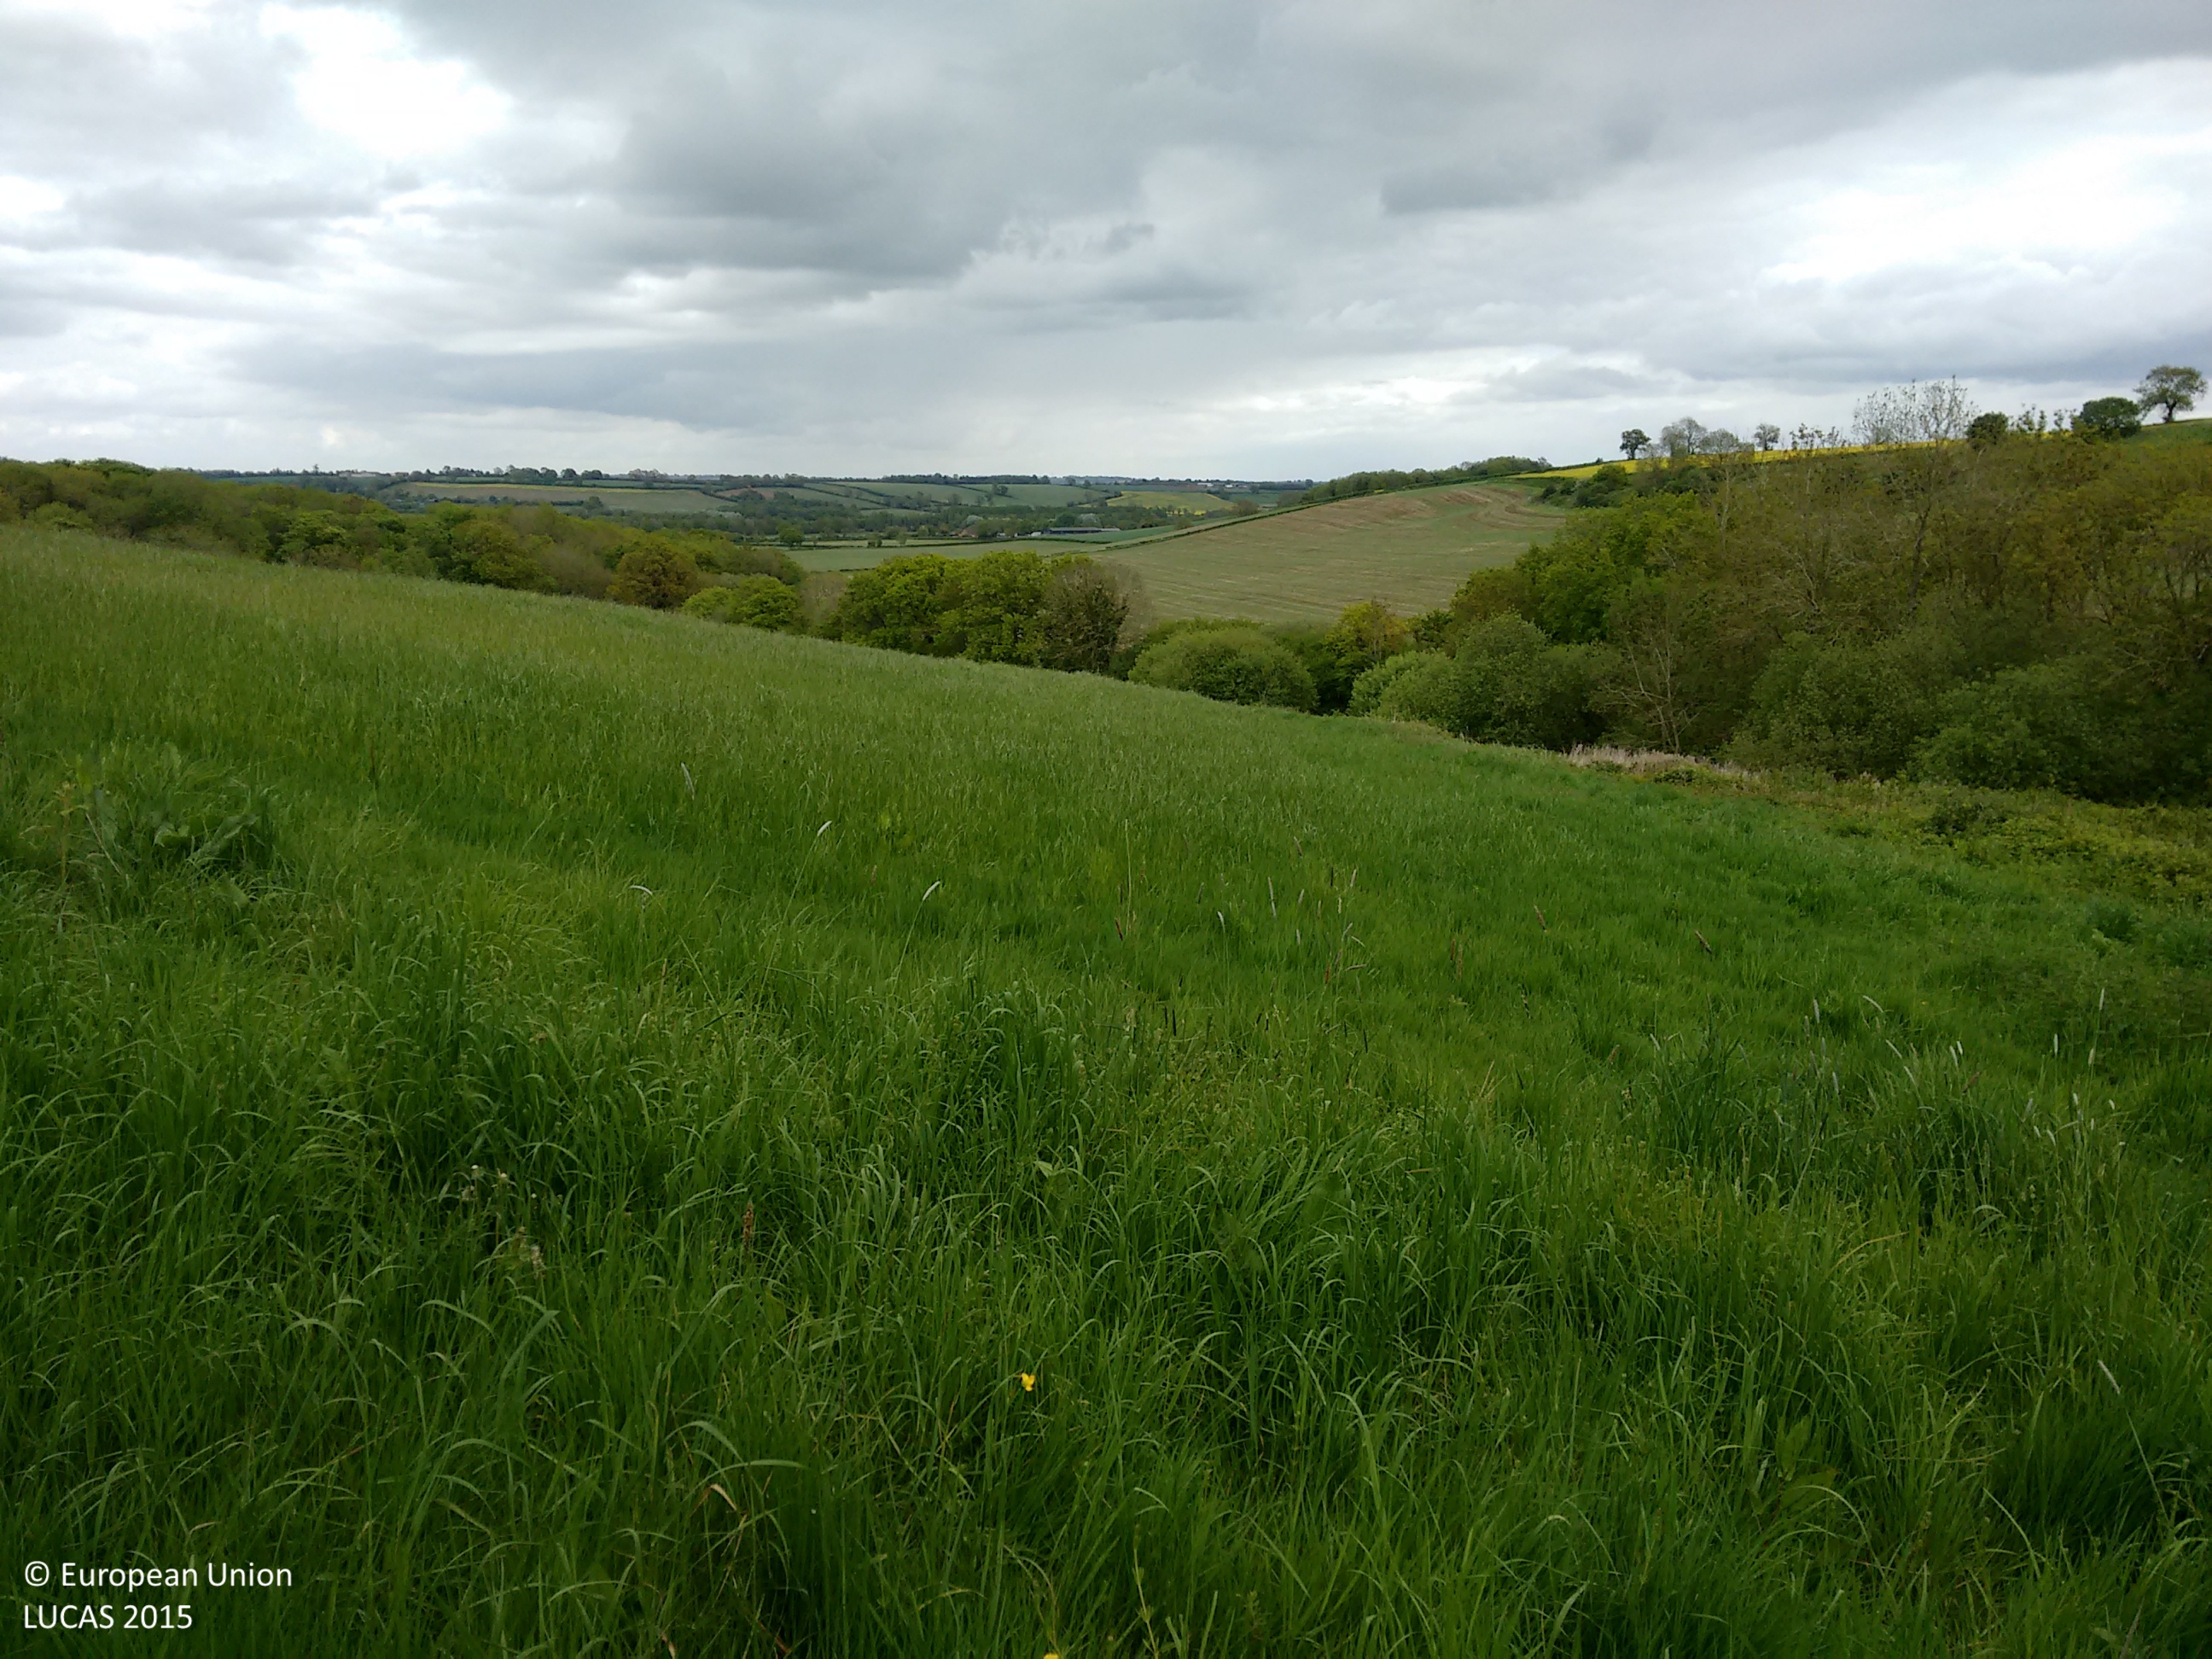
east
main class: Grassland
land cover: Grassland without tree/shrub cover
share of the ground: > 75 %
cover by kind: herbaceous plants 100 %
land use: Agriculture (excluding fallow land and kitchen gardens)
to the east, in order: Grassland without tree/shrub cover
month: May
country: GB
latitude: 52.1171
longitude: -1.3970
